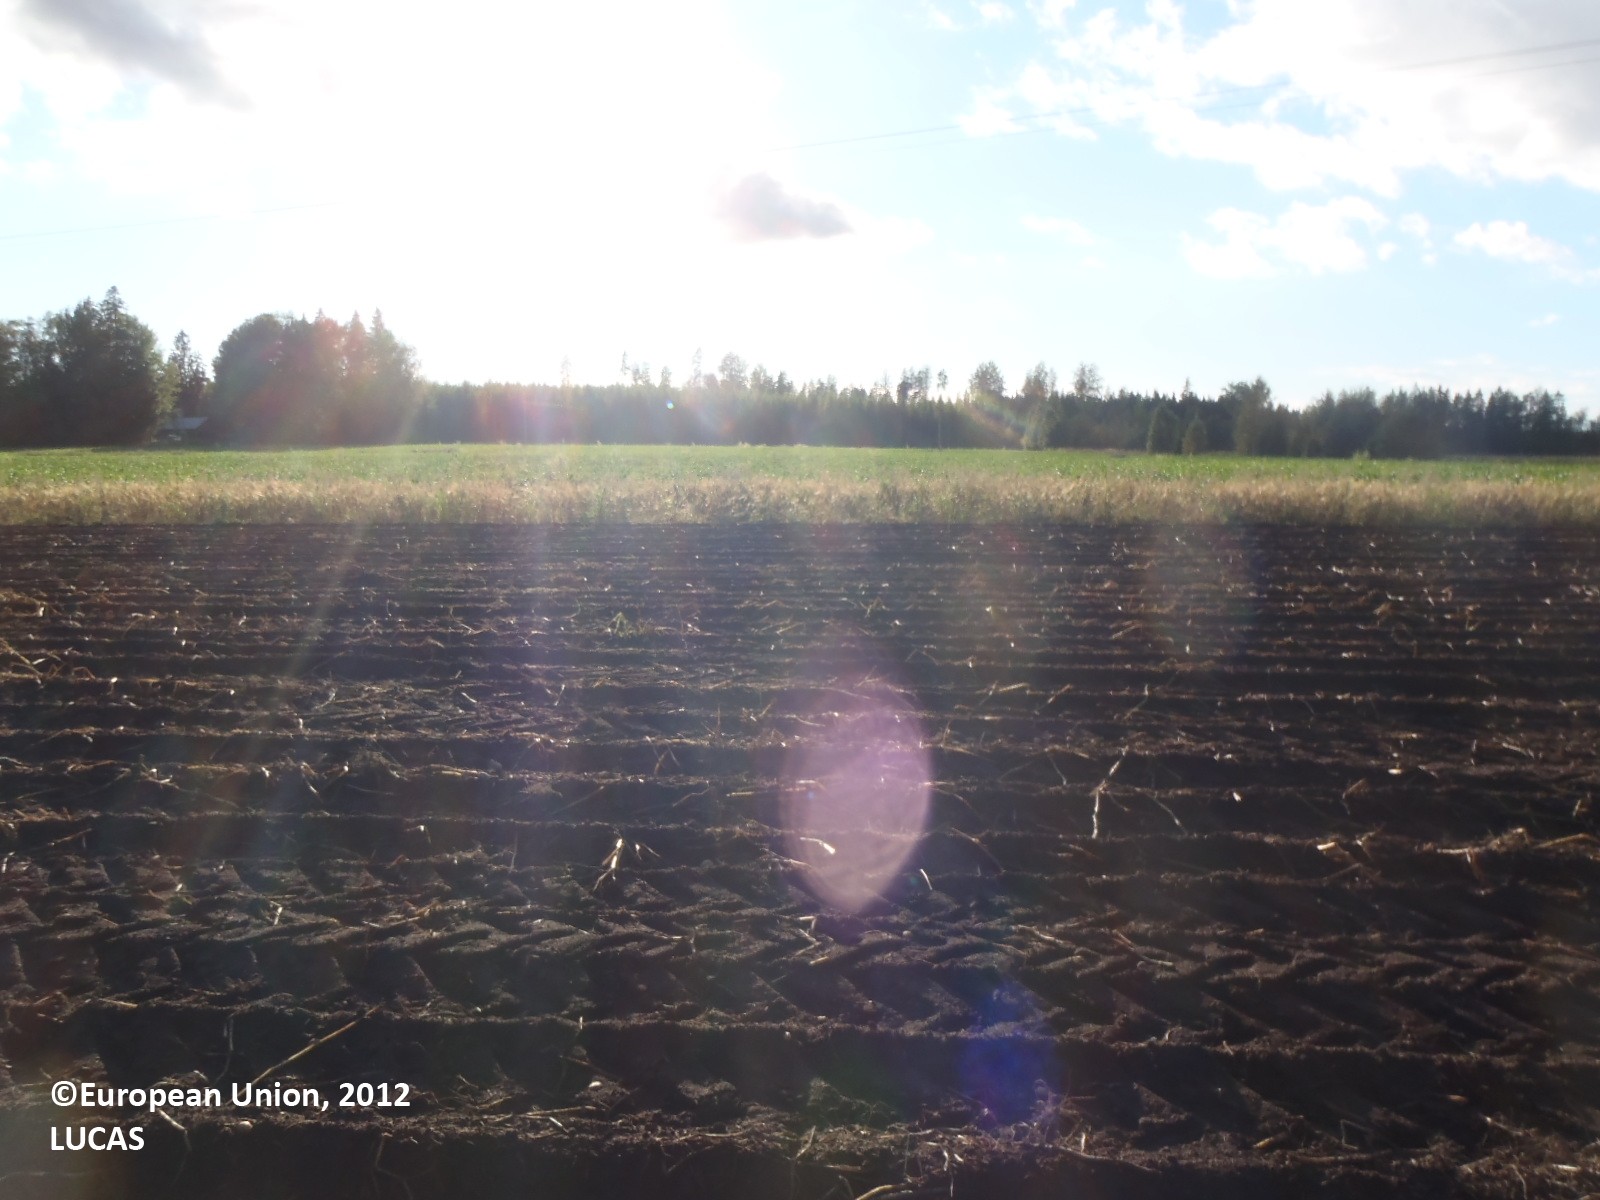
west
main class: Cropland
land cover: Potatoes
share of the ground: > 75 %
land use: Agriculture (excluding fallow land and kitchen gardens)
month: September
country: FI
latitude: 61.0796
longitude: 22.5426
